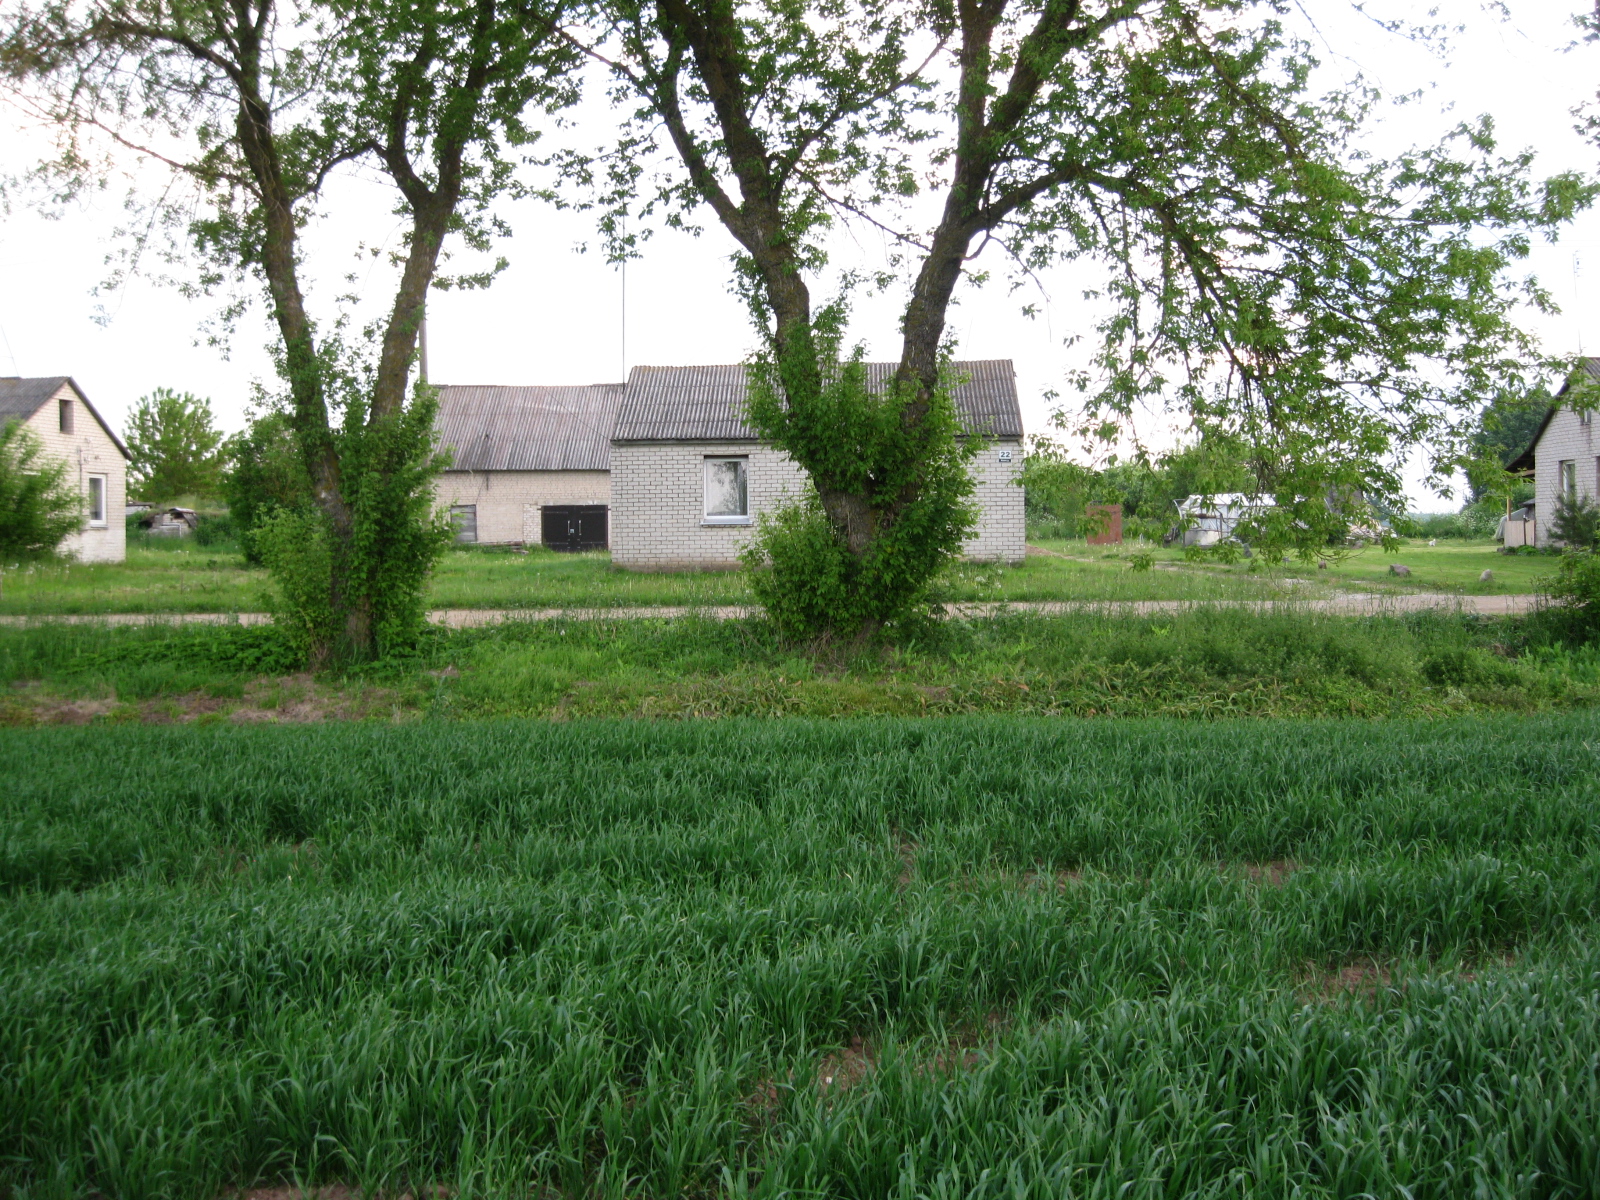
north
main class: Cropland
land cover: Common wheat
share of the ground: > 75 %
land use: Agriculture (excluding fallow land and kitchen gardens)
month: June
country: LT
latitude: 55.7236
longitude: 24.0197
